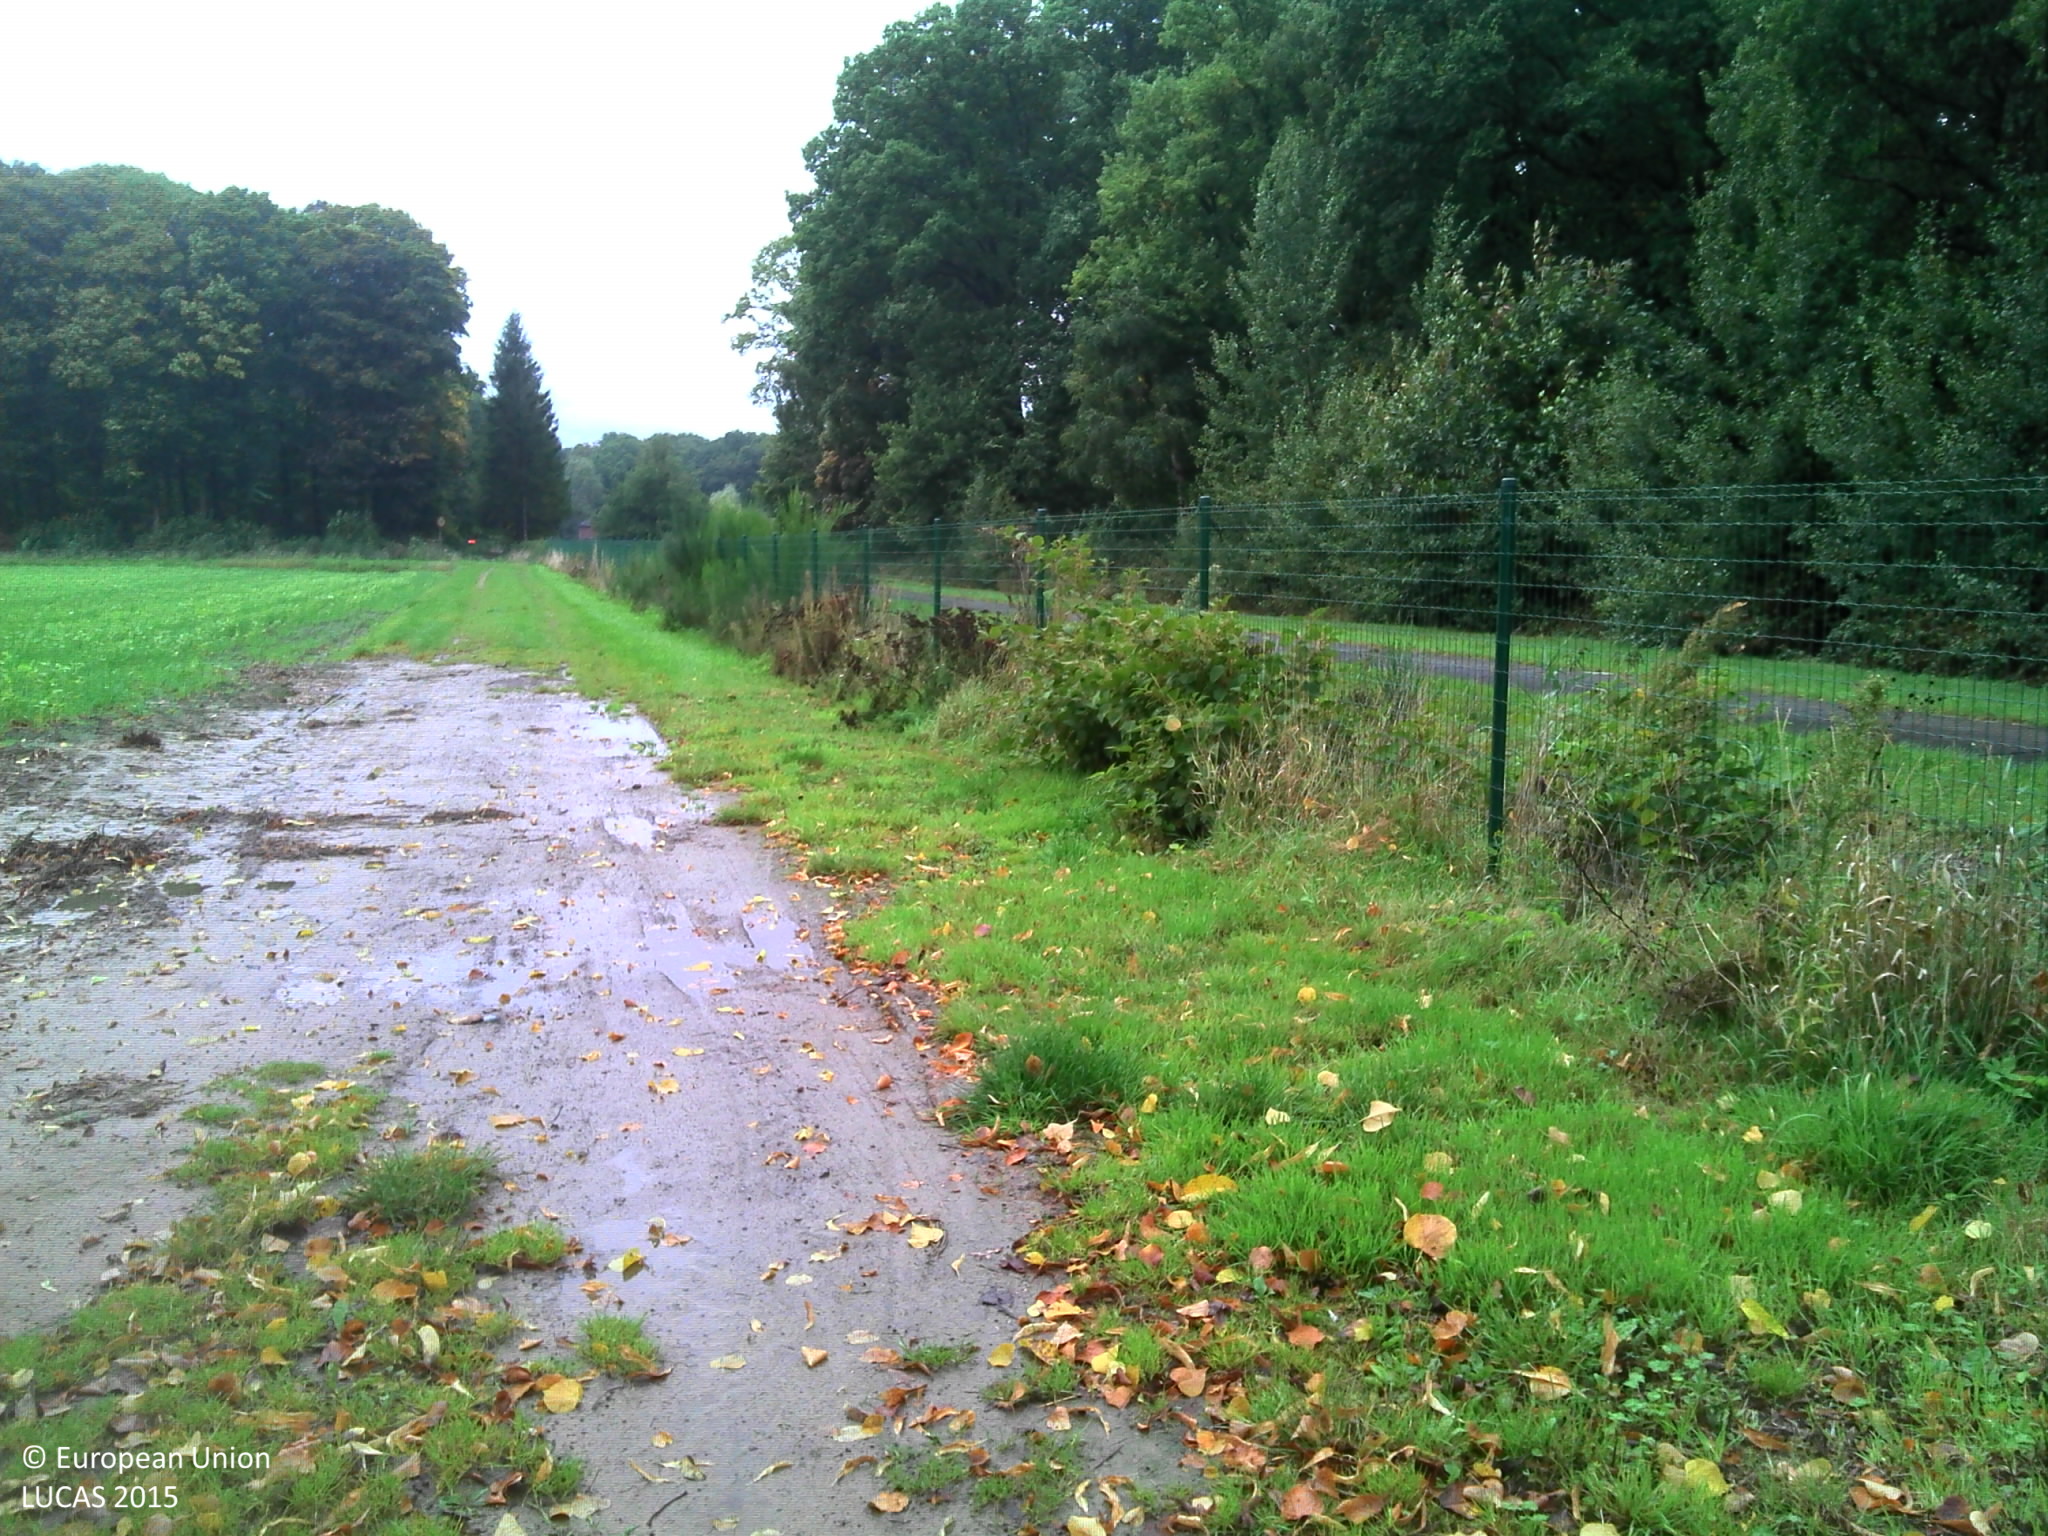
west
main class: Cropland
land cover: Other fibre and oleaginous crops
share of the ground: 50 - 75 %
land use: Agriculture (excluding fallow land and kitchen gardens)
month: October
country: BE
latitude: 50.9599
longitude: 2.9707
